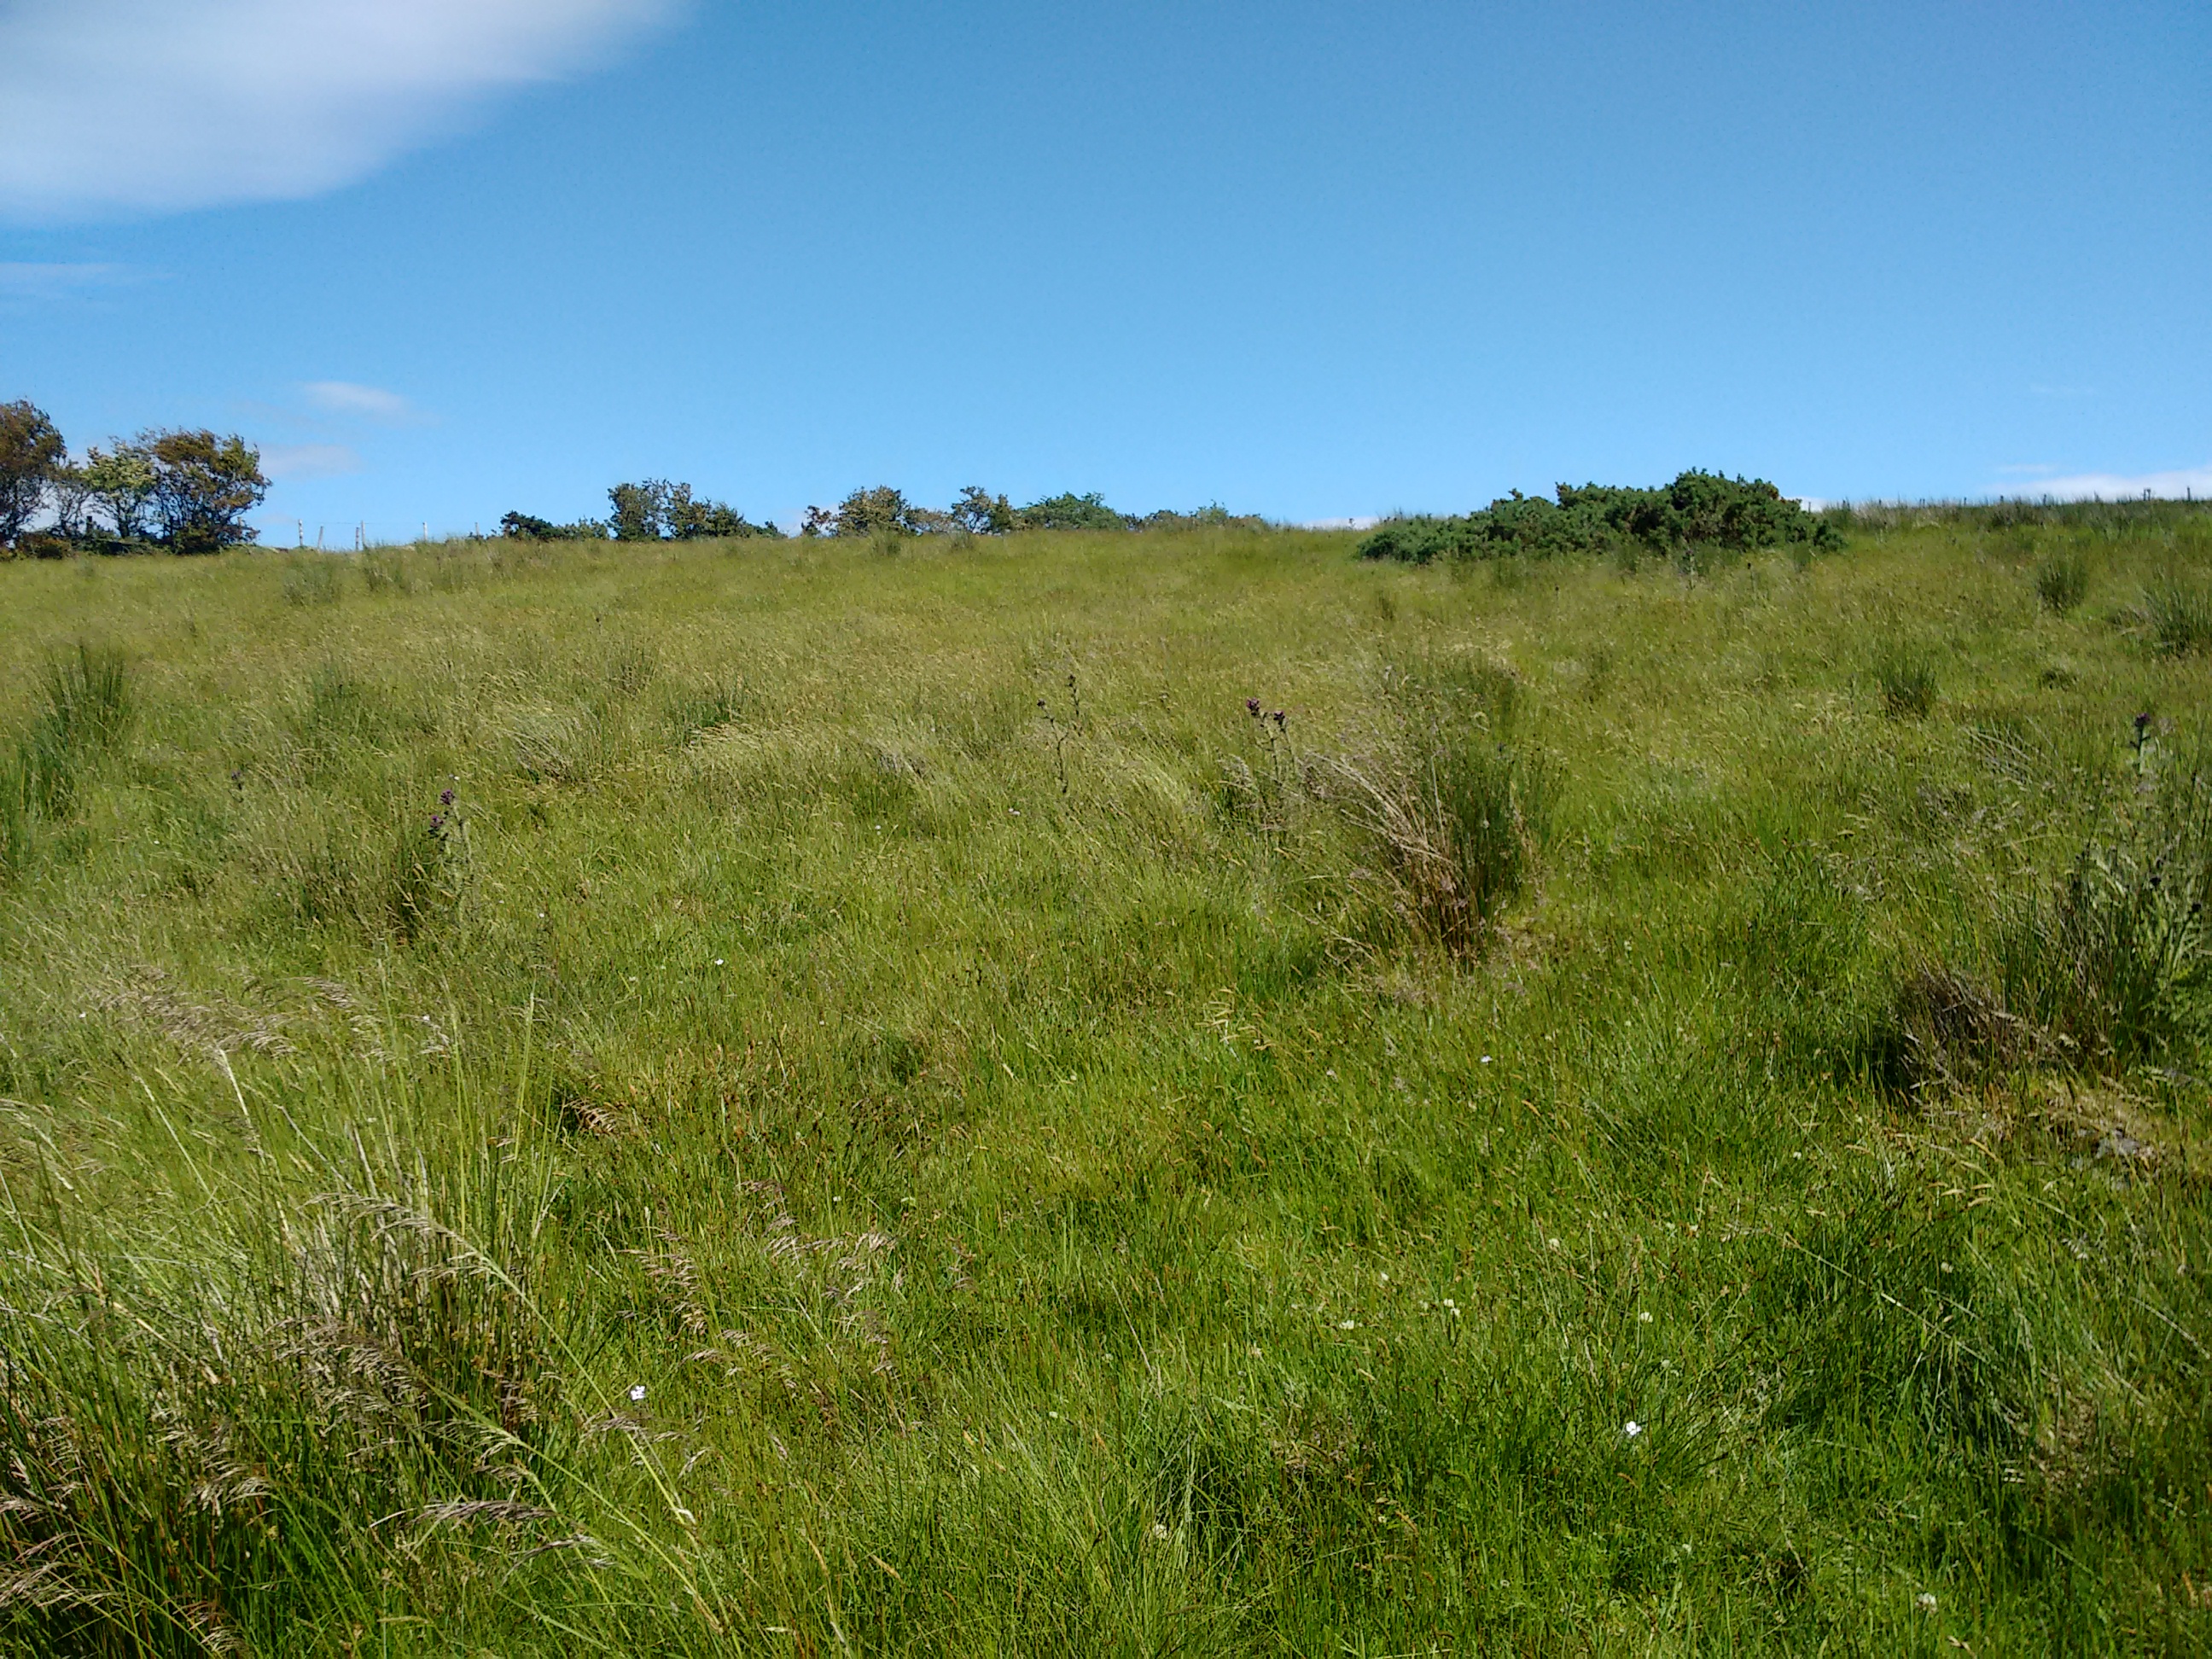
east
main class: Grassland
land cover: Grassland without tree/shrub cover
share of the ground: > 75 %
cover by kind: herbaceous plants 100 %
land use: Agriculture (excluding fallow land and kitchen gardens)
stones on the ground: < 10 %
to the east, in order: Grassland without tree/shrub cover; Ditches and canals; Abandoned hedges; Fences; Grassland without tree/shrub cover; Fences; Abandoned hedges; Grassland without tree/shrub cover; Fences; Abandoned hedges; Grassland without tree/shrub cover
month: June
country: GB
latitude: 55.2087
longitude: -6.1566
